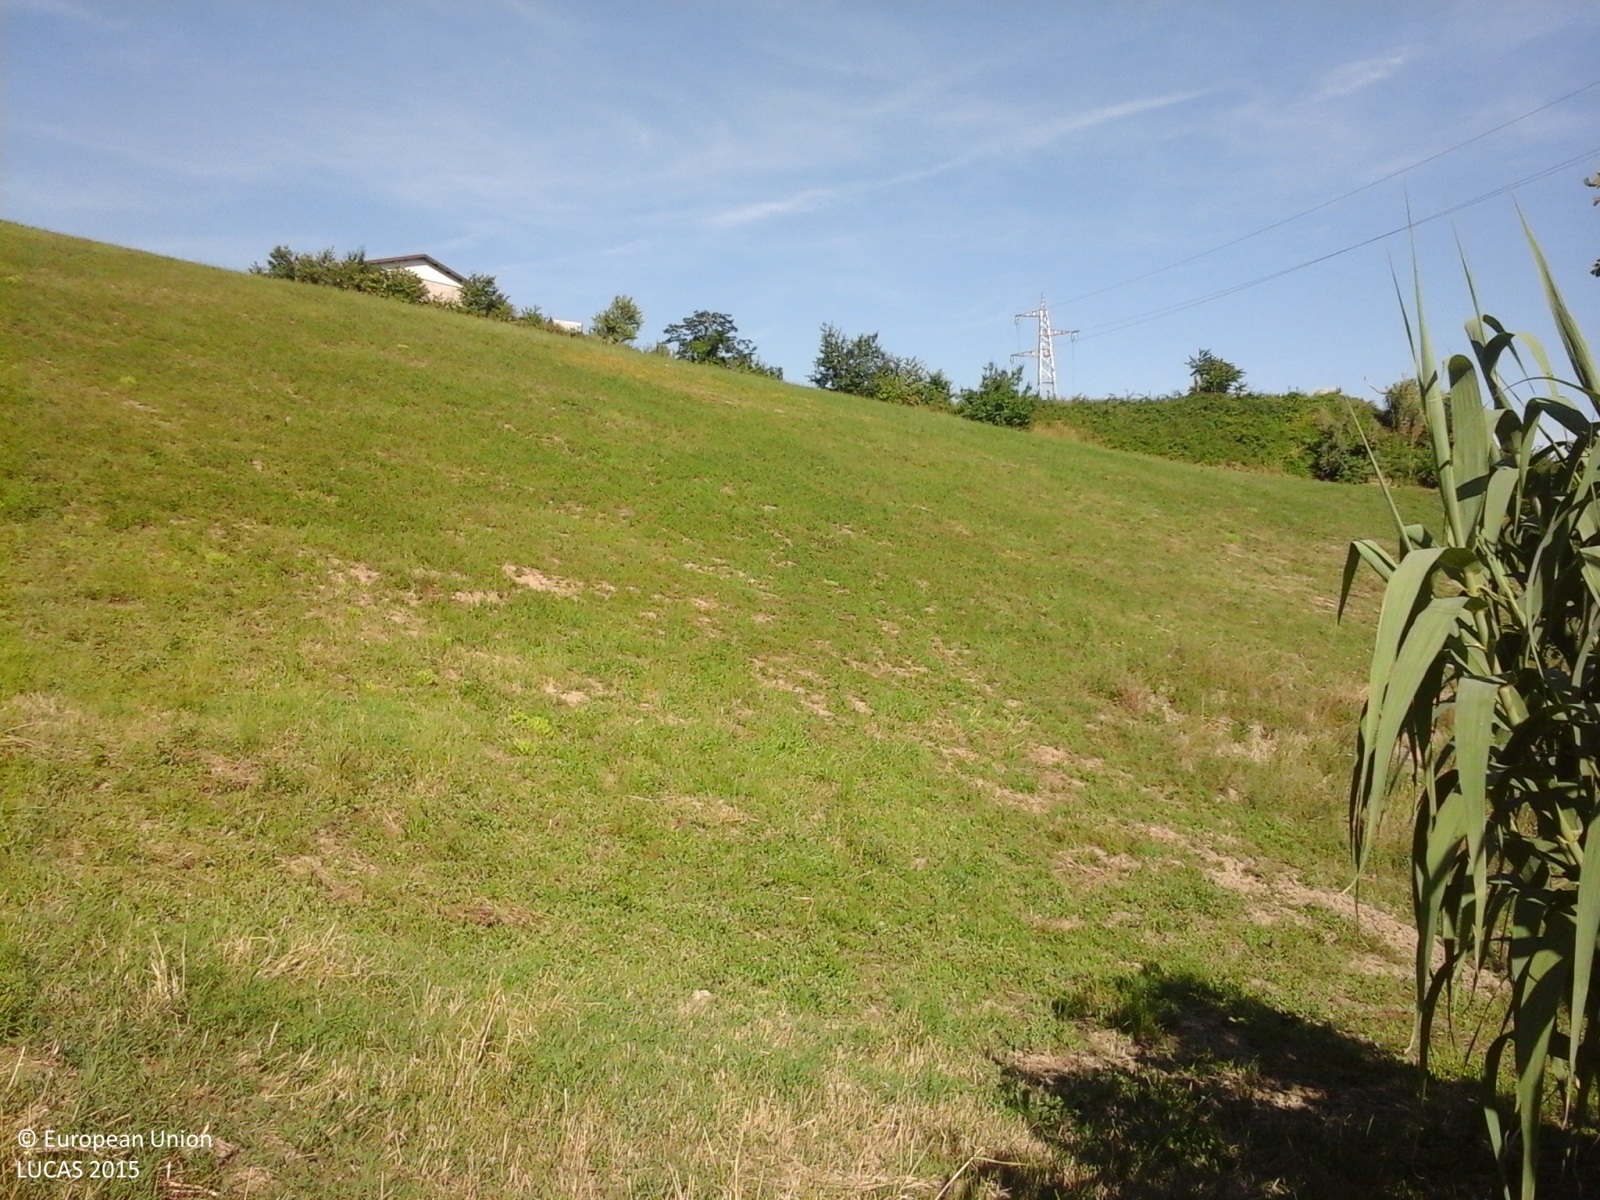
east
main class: Cropland
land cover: Durum wheat
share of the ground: > 75 %
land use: Agriculture (excluding fallow land and kitchen gardens)
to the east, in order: Durum wheat; Broadleaved woodland; Other leguminous and mixtures for fodder; Shrubland without tree cover; Spontaneously vegetated surfaces; Artificial constructions in urban areas
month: June
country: IT
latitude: 42.1856
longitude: 14.2366
